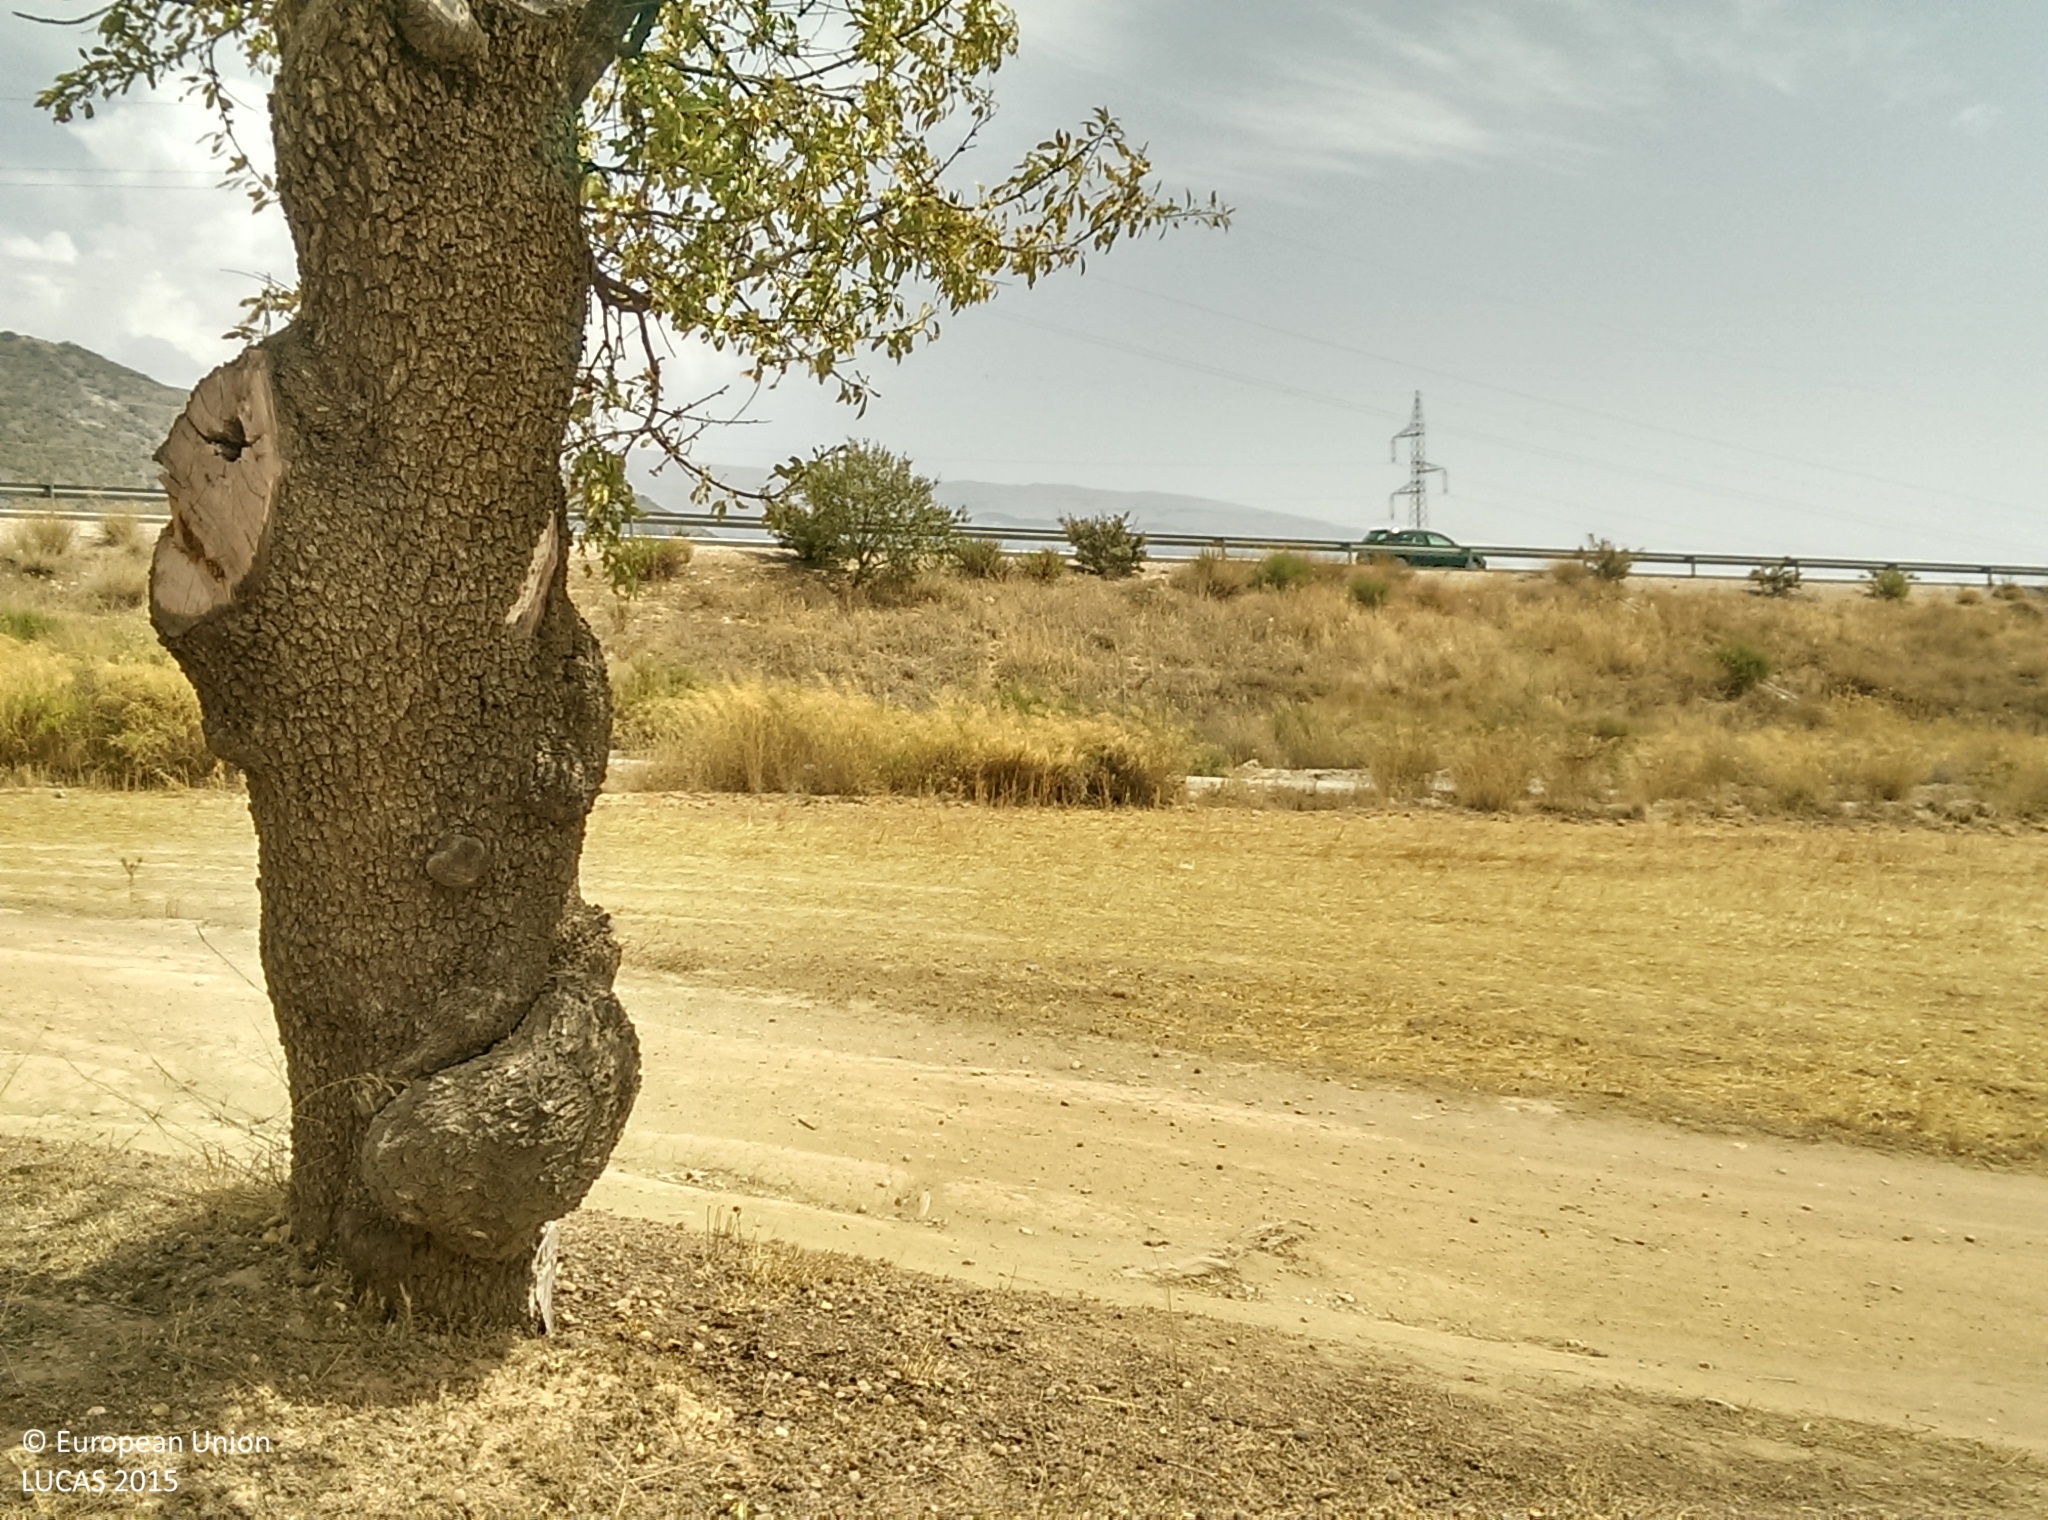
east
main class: Cropland
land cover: Nuts trees
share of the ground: 10 - 25 %
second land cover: Other bare soil
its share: > 75 %
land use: Agriculture (excluding fallow land and kitchen gardens)
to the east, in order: Nuts trees; Other bare soil; Tracks; Grassland without tree/shrub cover; Tracks; Grassland without tree/shrub cover; Fences; Shrubland with sparse tree cover; Paved roads, cycling and walking lanes; Shruby margins; Ditches and canals; Shruby margins; Paved roads, cycling and walking lanes; Grassland without tree/shrub cover; Fences; Grassland without tree/shrub cover; Tracks; Other structural elements; Barley; Electric lines; Barley
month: August
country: ES
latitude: 37.0343
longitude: -3.6464
